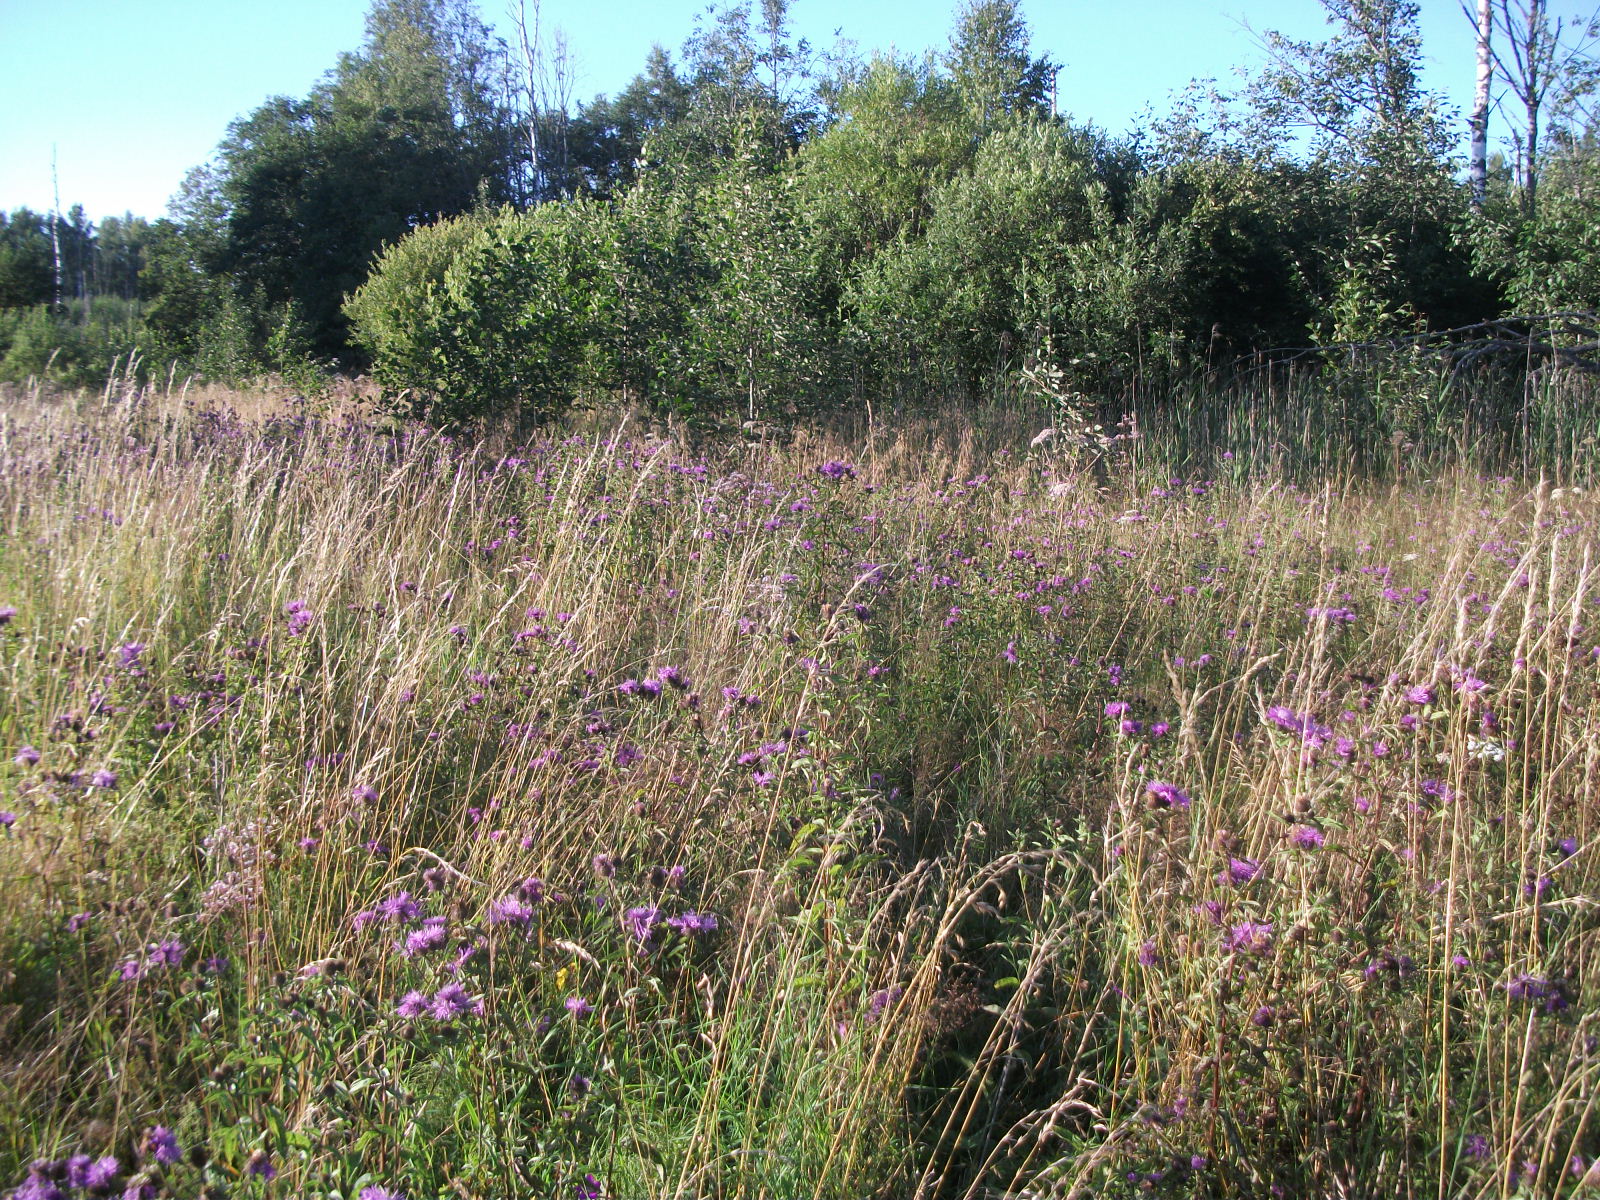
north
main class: Grassland
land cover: Grassland with sparse tree/shrub cover
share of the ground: > 75 %
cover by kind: herbaceous plants 90 %, broadleaved forest trees 5 %, shrubs 5 %
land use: Semi-natural and natural areas not in use
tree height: < 5 m
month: August
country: LV
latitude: 57.0614
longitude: 26.4861
